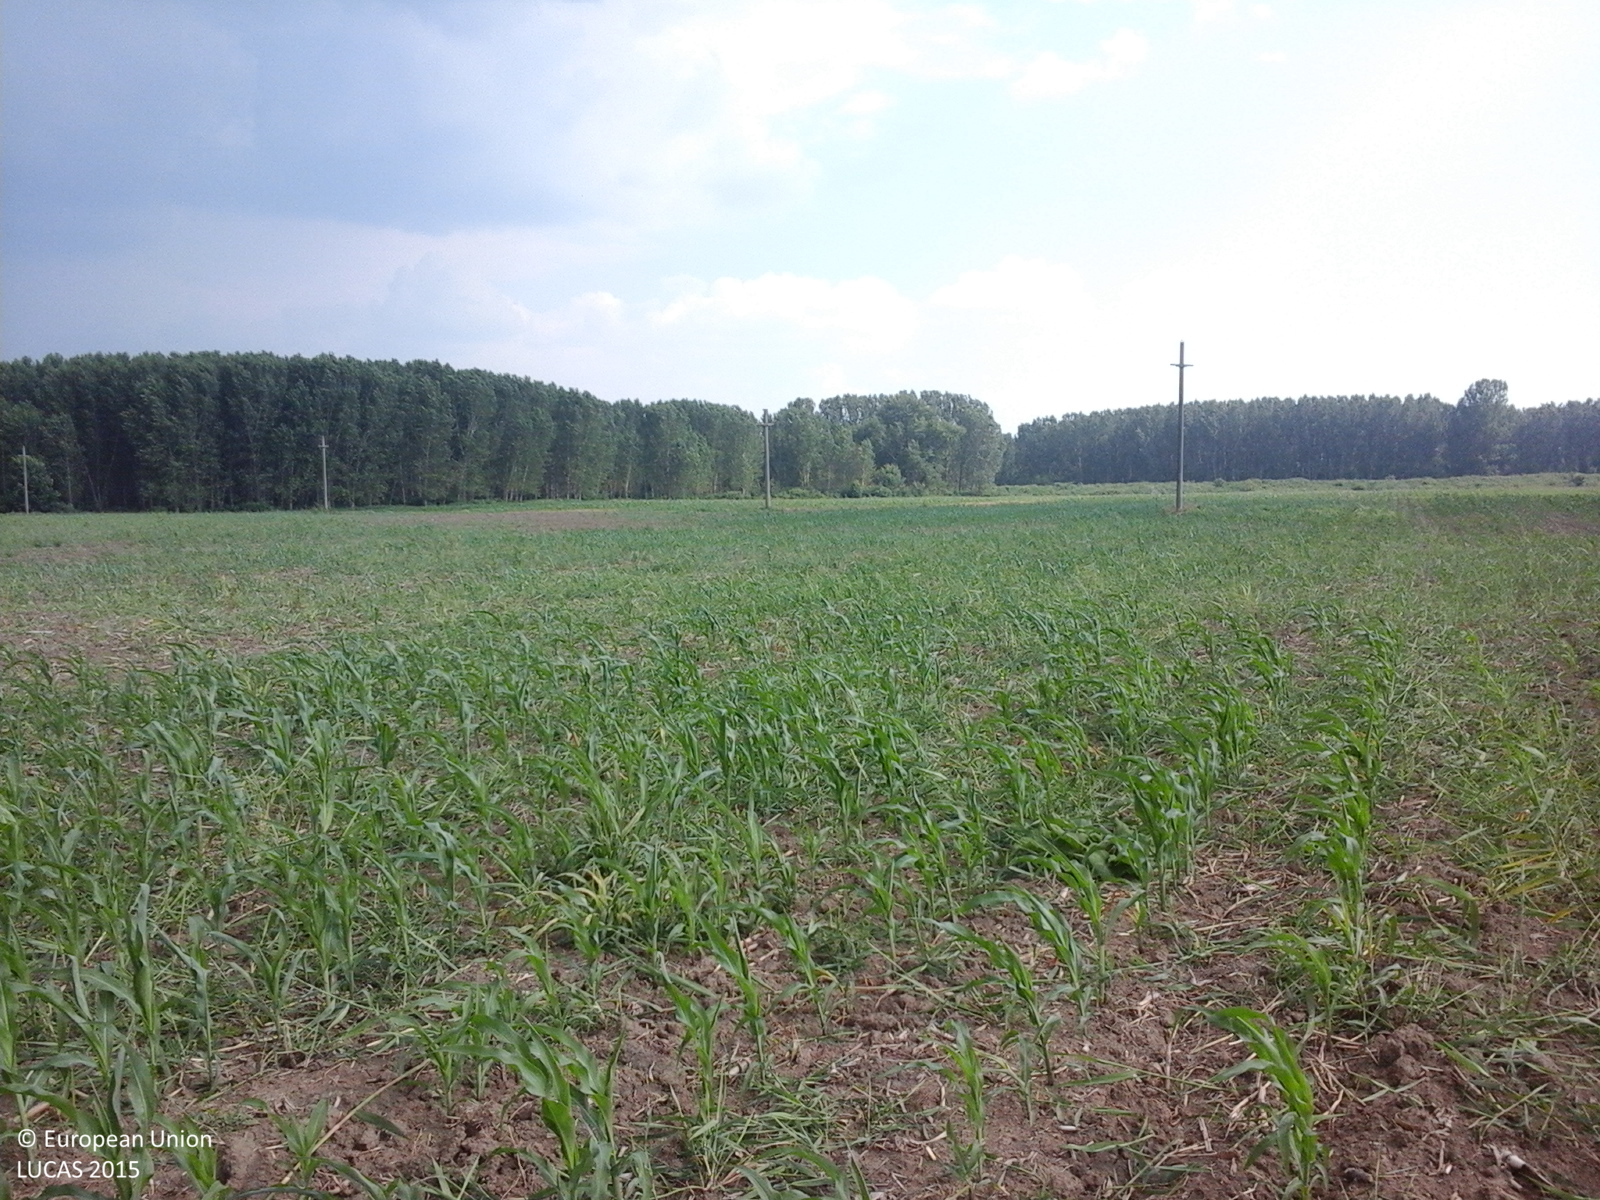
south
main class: Cropland
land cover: Maize
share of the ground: 10 - 25 %
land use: Agriculture (excluding fallow land and kitchen gardens)
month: July
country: RO
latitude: 43.6960
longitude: 25.1010
